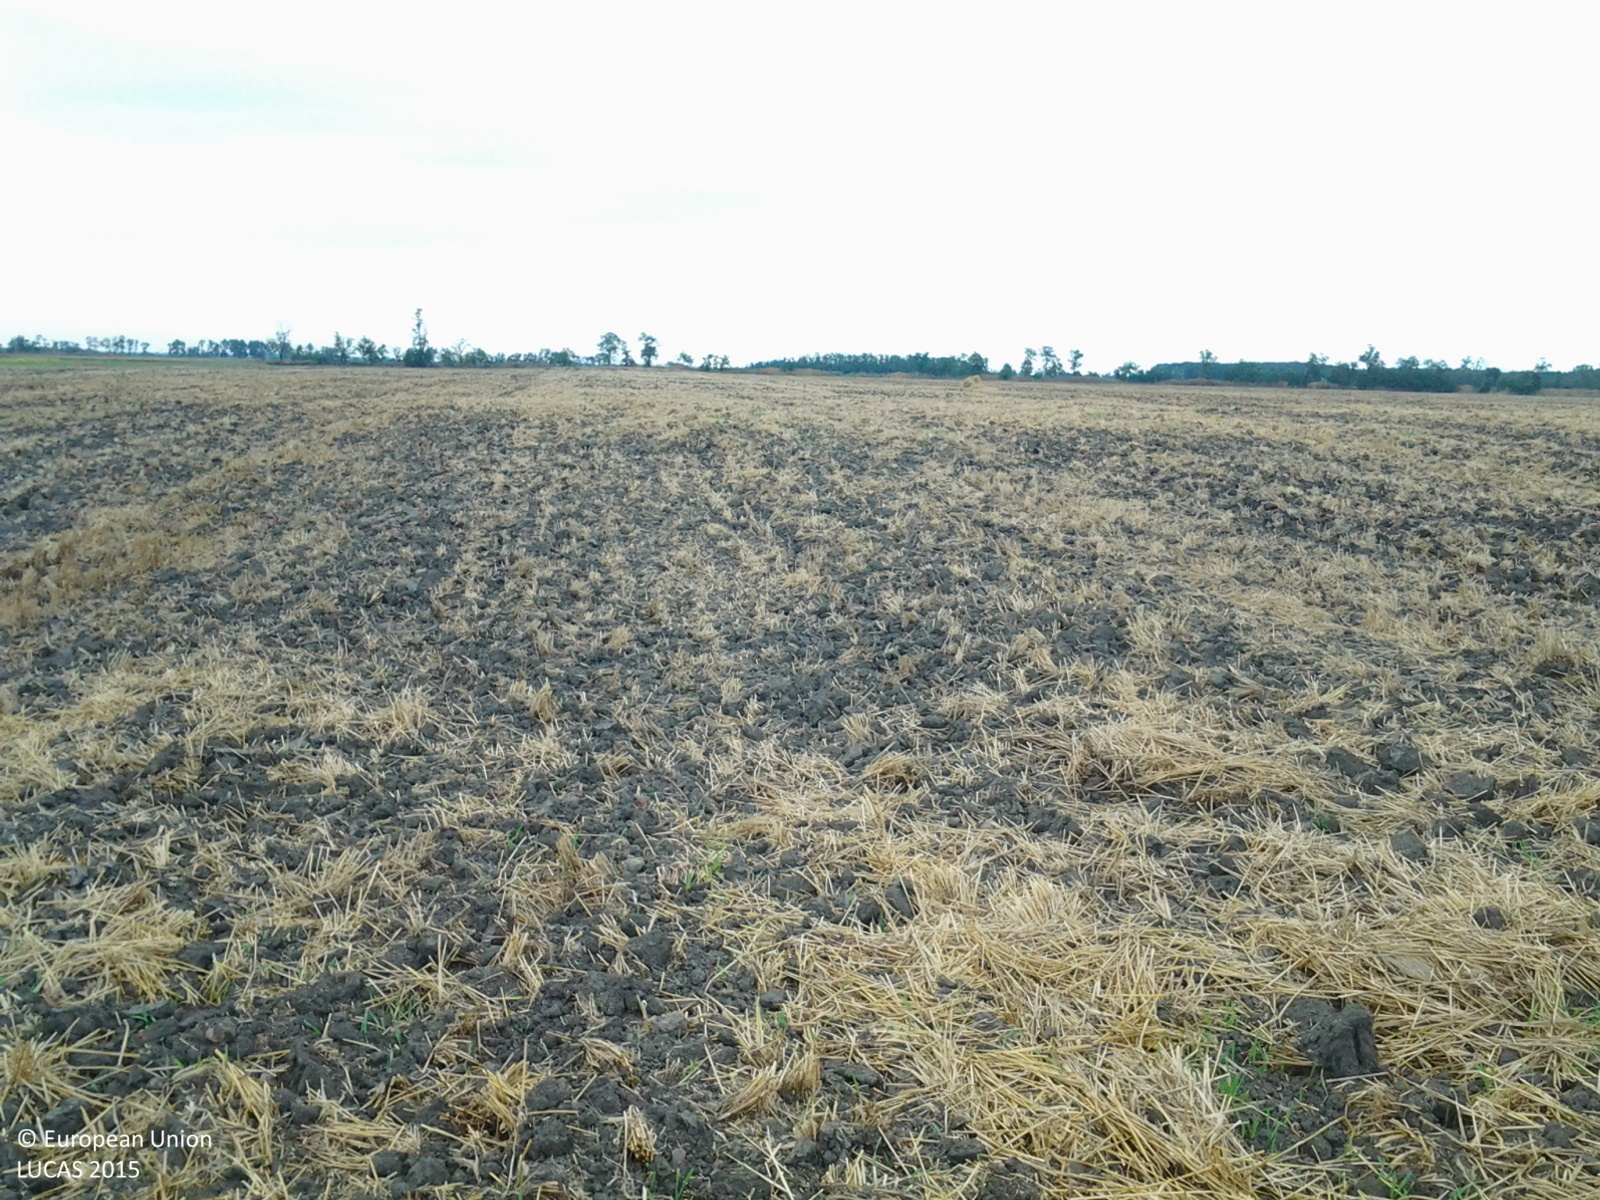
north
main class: Cropland
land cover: Barley
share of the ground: < 10 %
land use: Agriculture (excluding fallow land and kitchen gardens)
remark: Harvested field
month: July
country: HU
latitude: 47.1719
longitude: 20.5452
